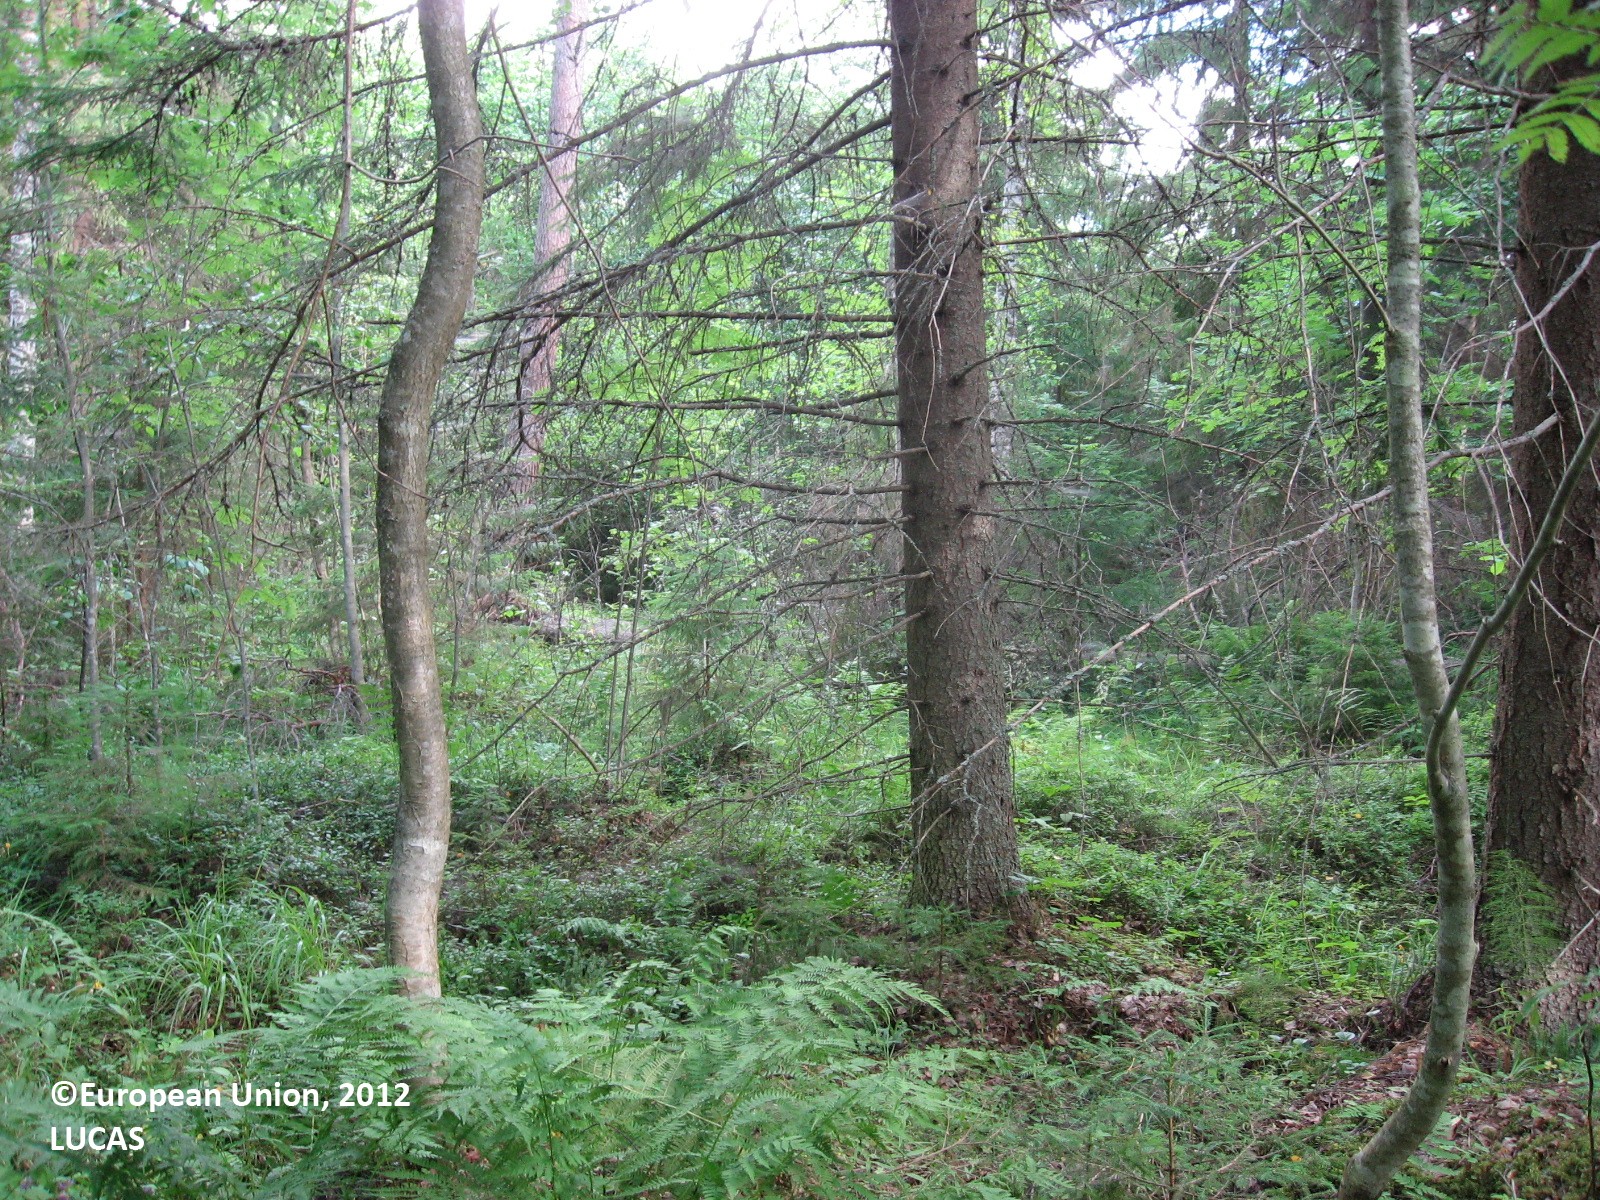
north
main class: Woodland
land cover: Spruce dominated mixed woodland
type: boreal forest
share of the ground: 50 - 75 %
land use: Forestry
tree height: > 5 m
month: July
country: FI
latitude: 61.2611
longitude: 25.3899
